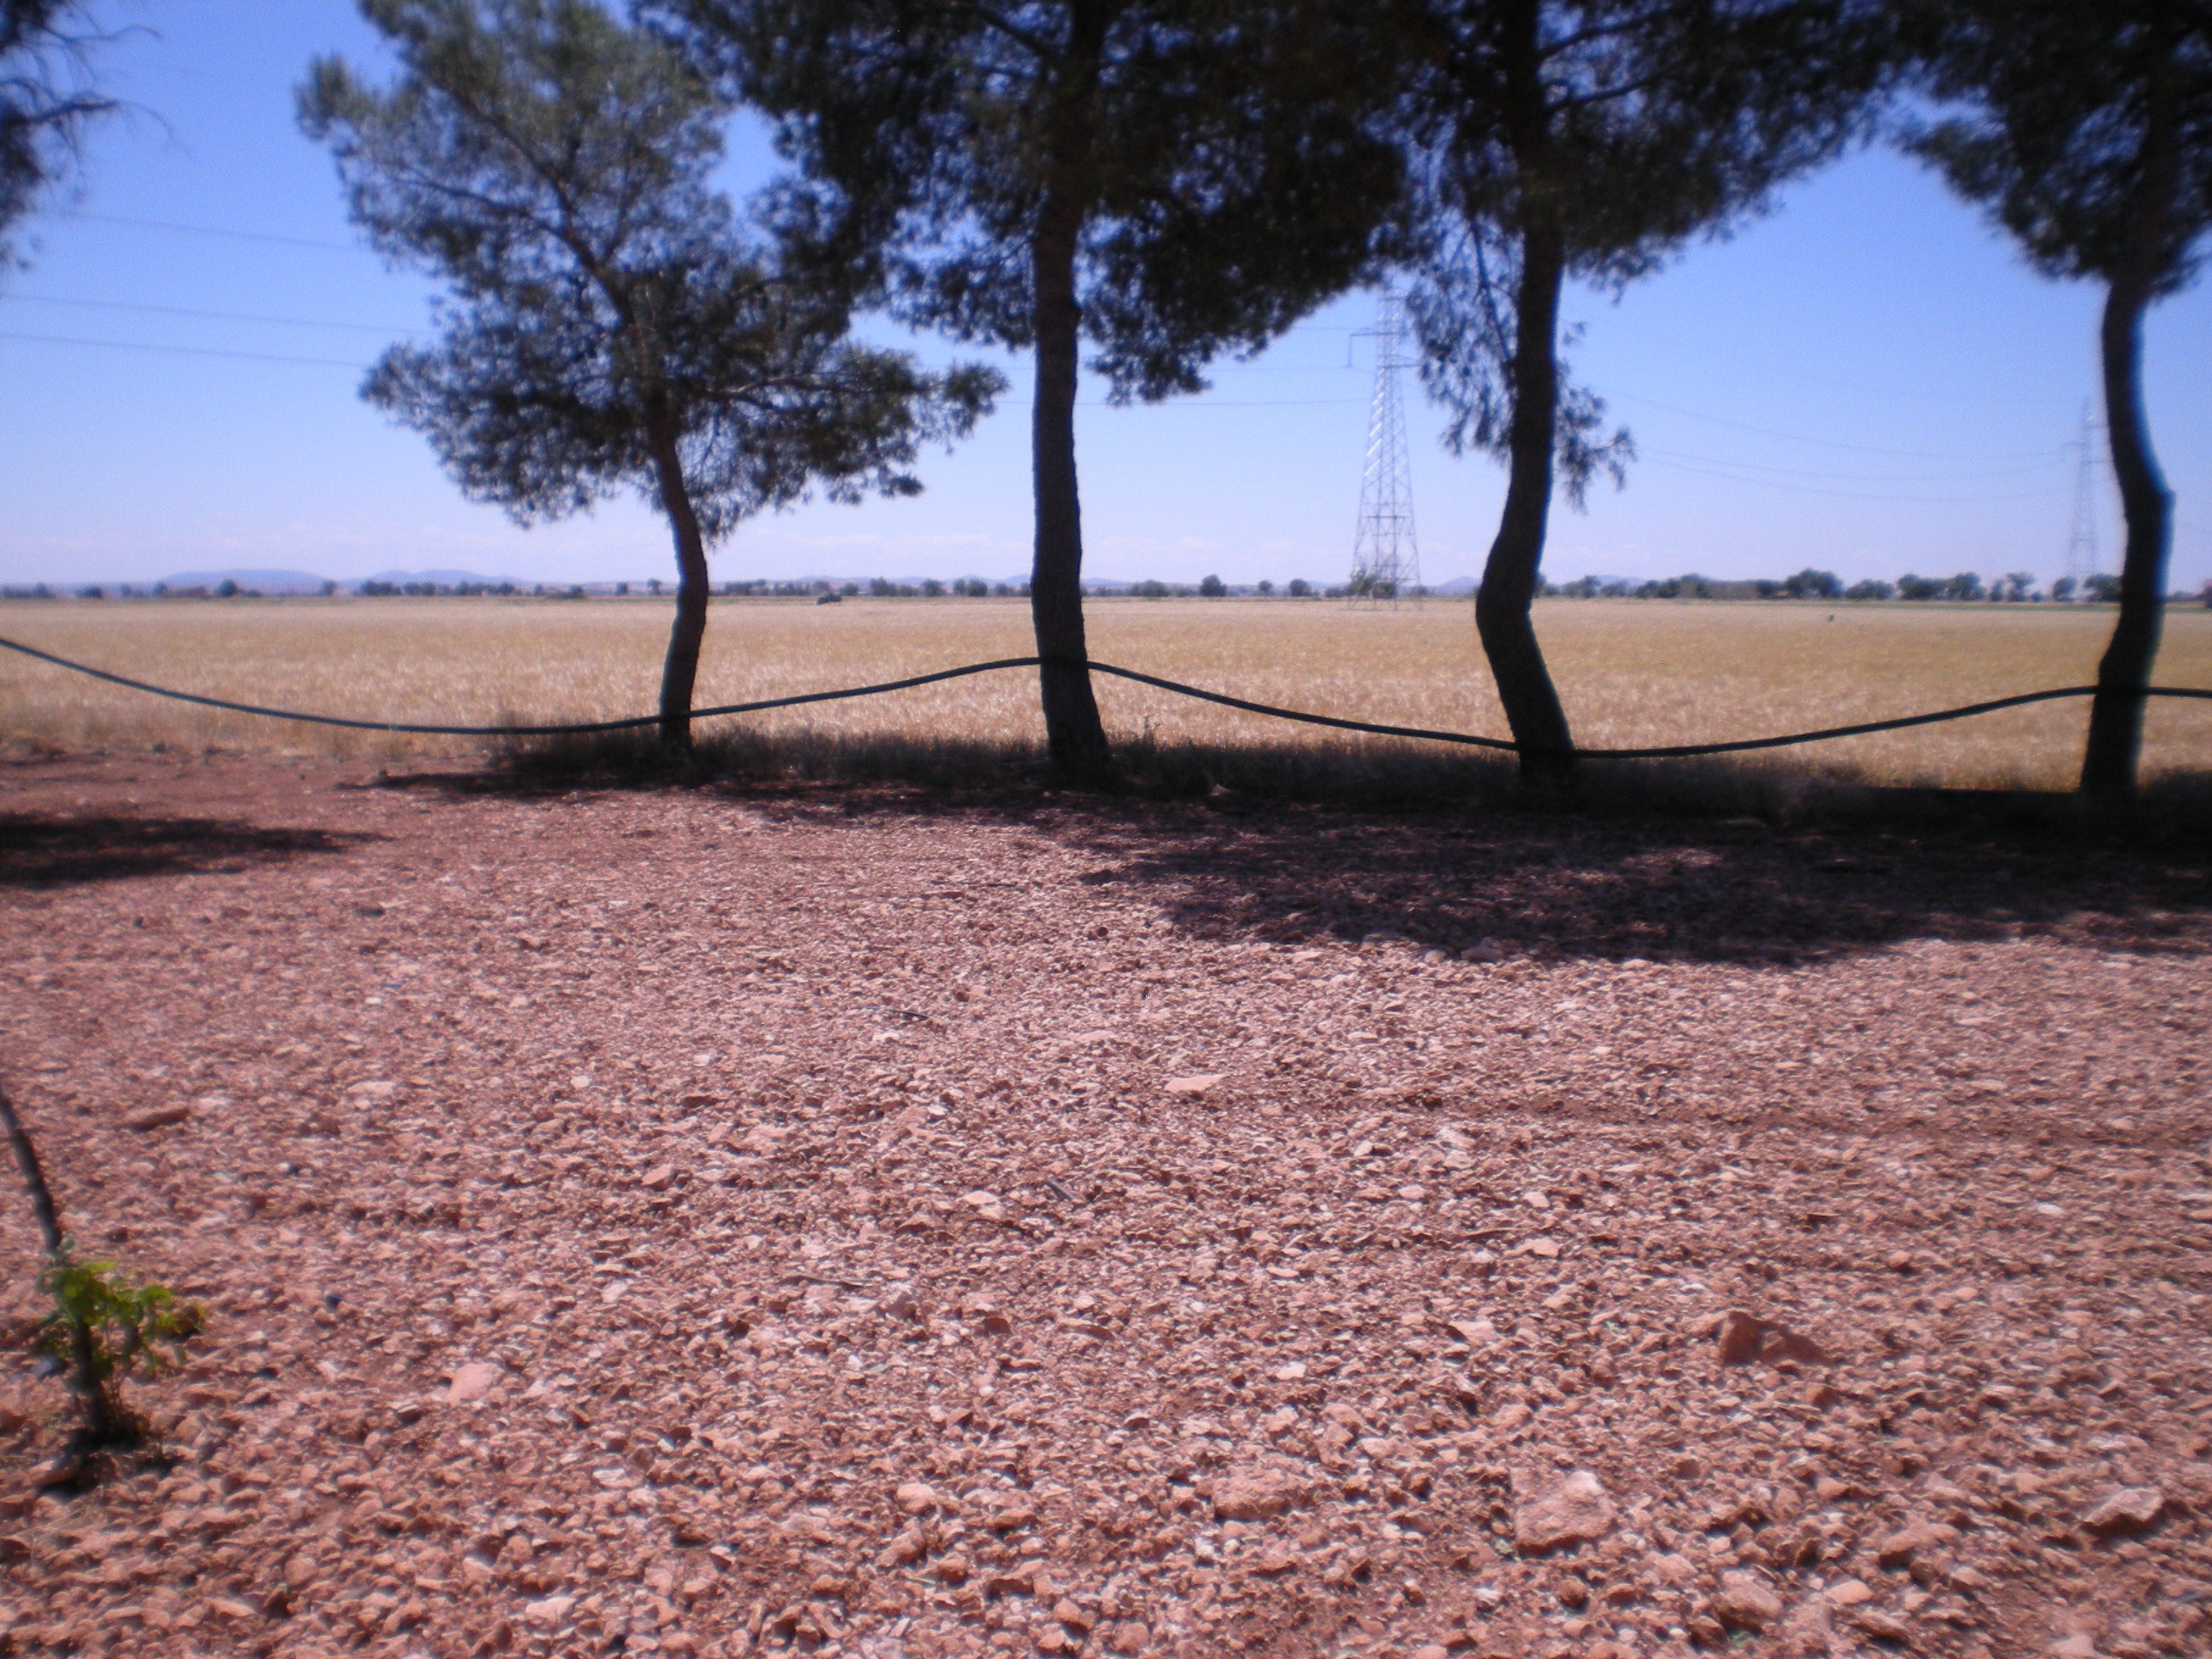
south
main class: Cropland
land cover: Other fruit trees and berries
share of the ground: < 10 %
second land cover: Other bare soil
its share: > 75 %
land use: Kitchen garden
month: May
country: ES
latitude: 39.1365
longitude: -3.3082
